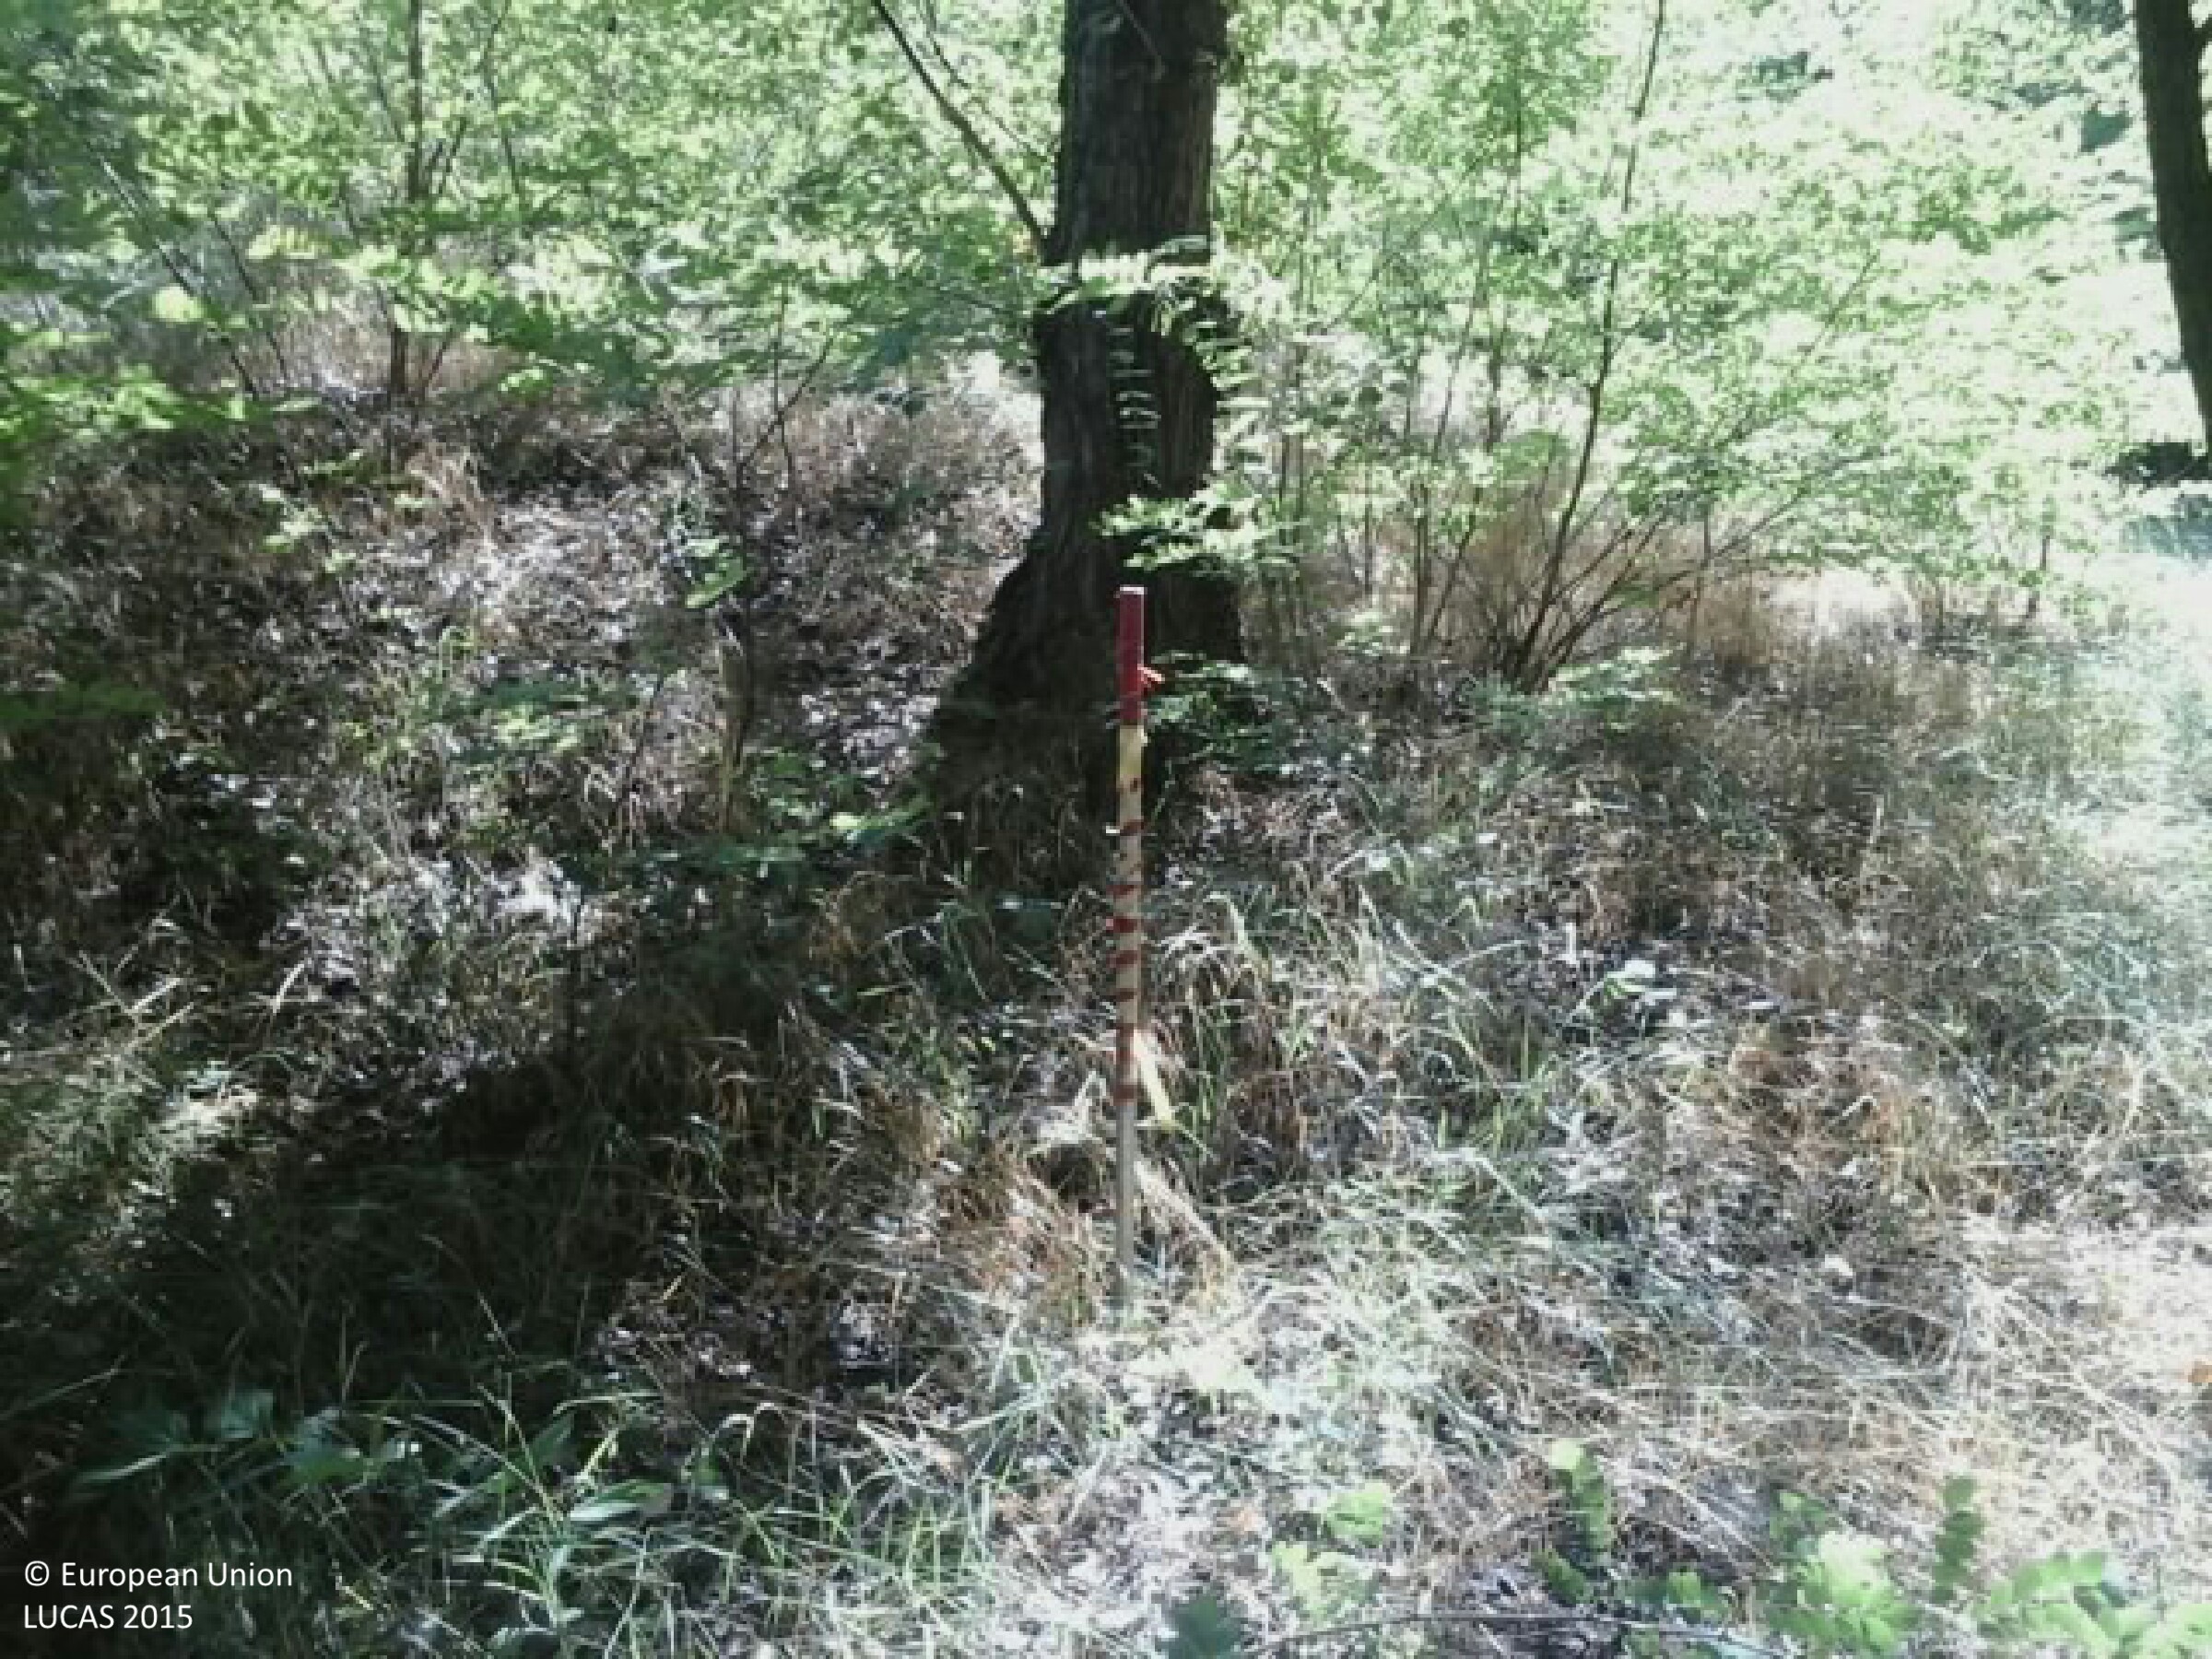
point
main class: Woodland
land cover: Broadleaved woodland
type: exotic forest
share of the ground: 50 - 75 %
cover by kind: broadleaved forest trees 90 %, herbaceous plants 10 %
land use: Forestry
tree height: > 5 m
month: June
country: HU
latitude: 46.8404
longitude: 19.6312
